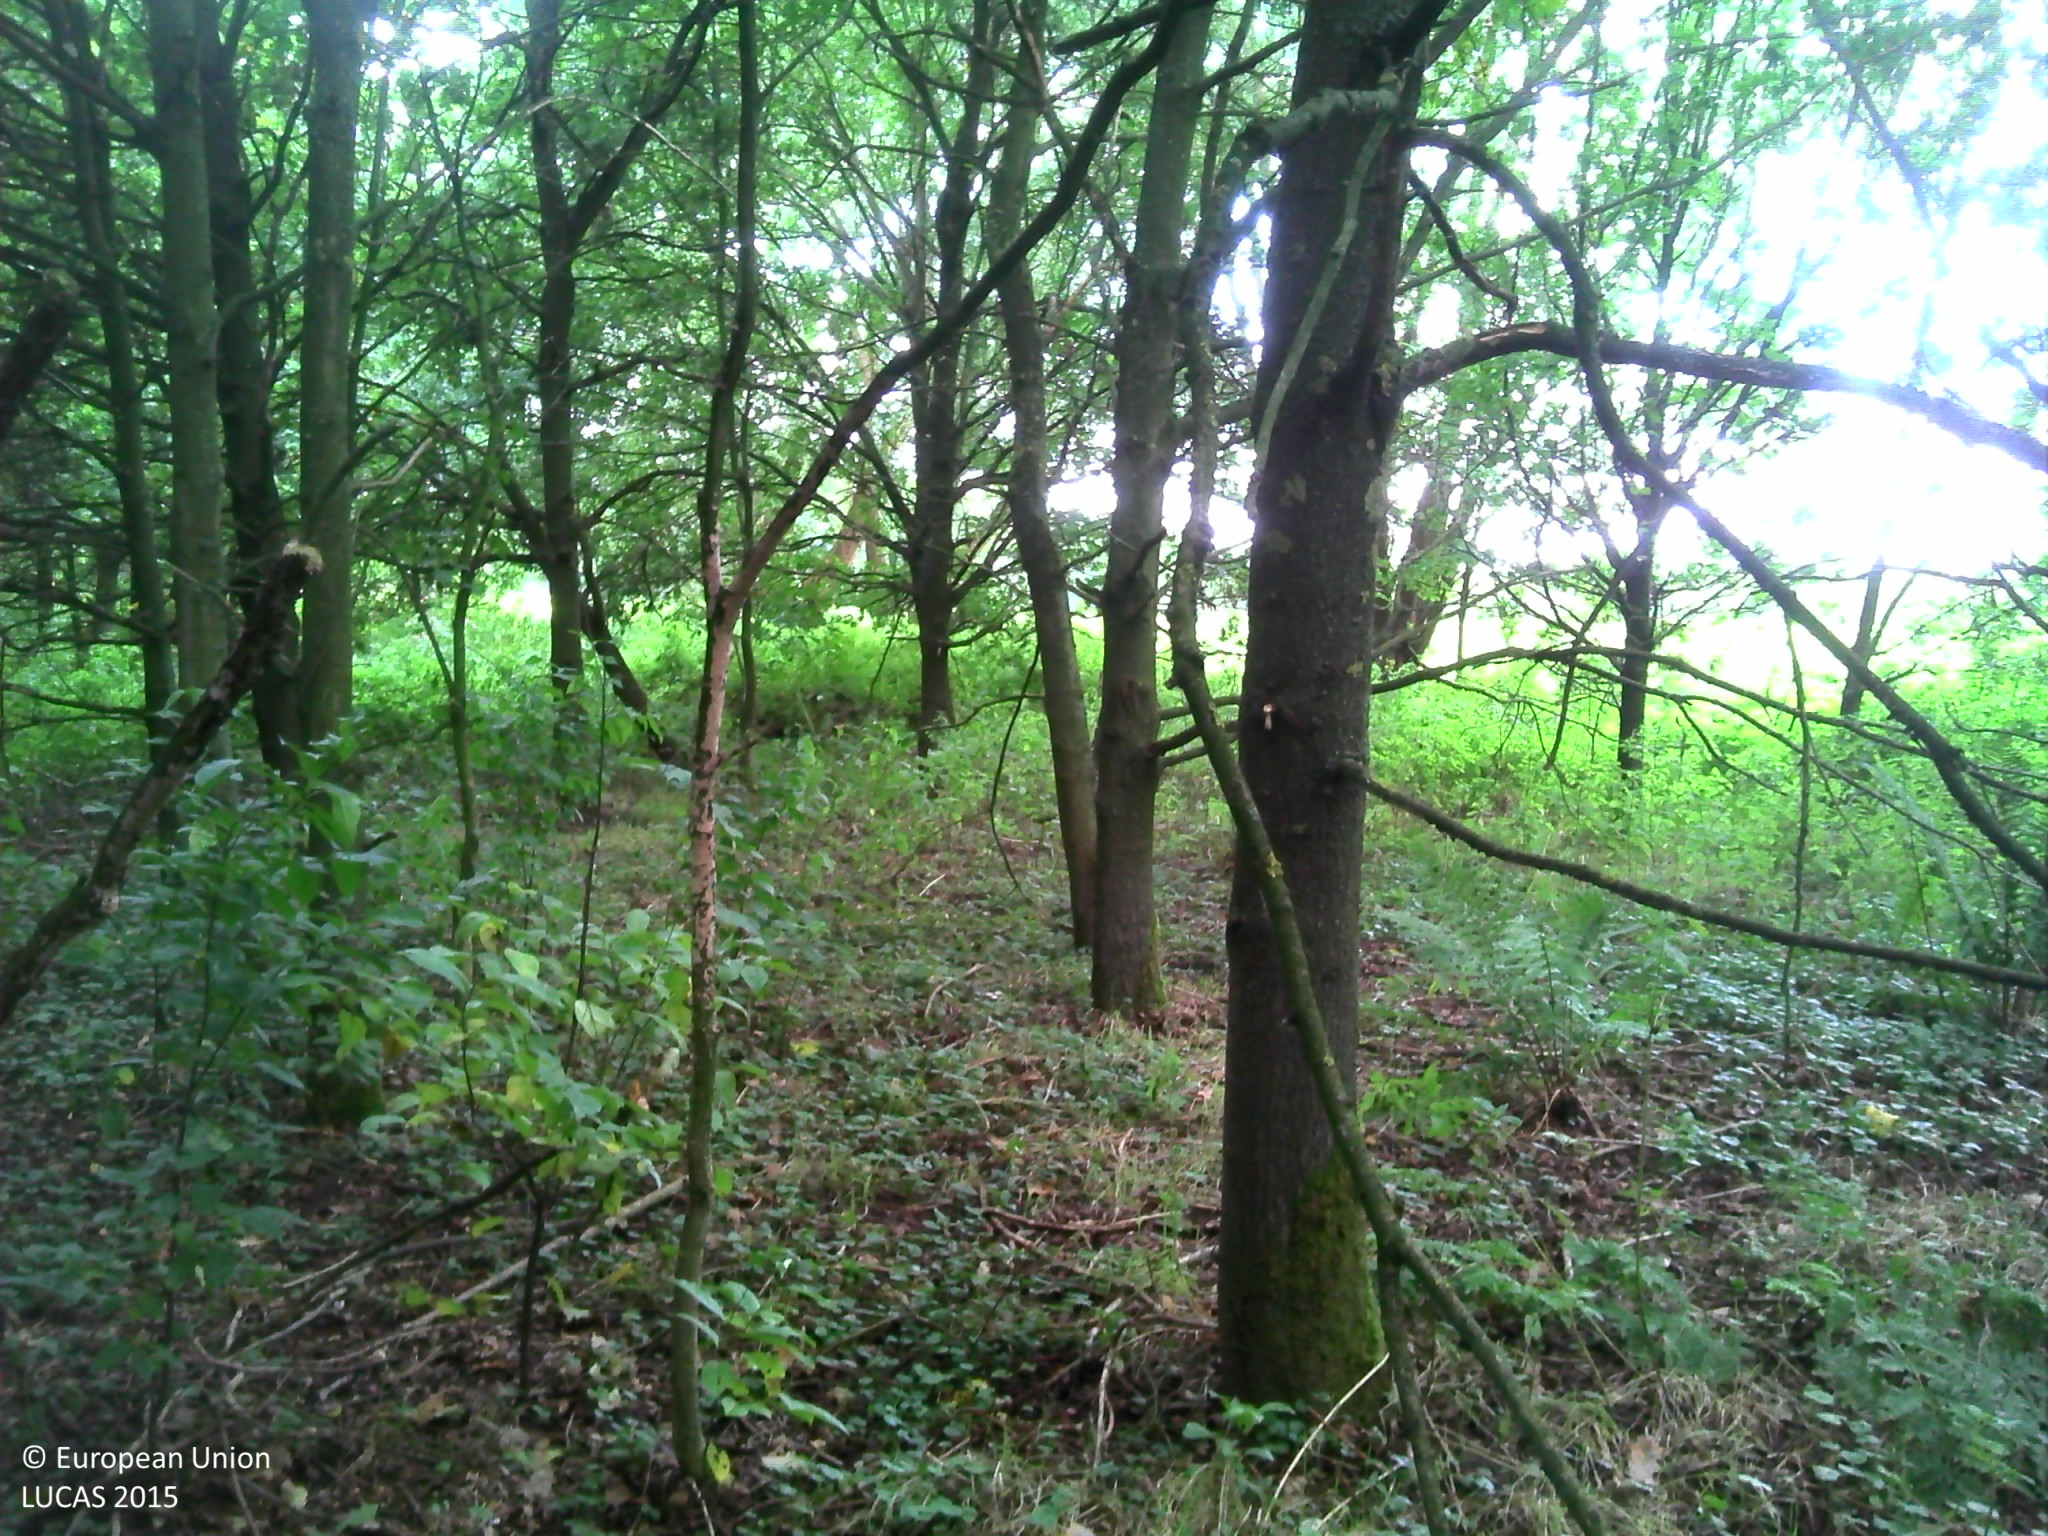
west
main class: Woodland
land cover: Broadleaved woodland
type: mesophytic deciduous forest
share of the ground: > 75 %
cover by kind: broadleaved forest trees 75 %, herbaceous plants 25 %
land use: Forestry
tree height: > 5 m
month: September
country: BE
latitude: 51.0330
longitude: 4.6773
